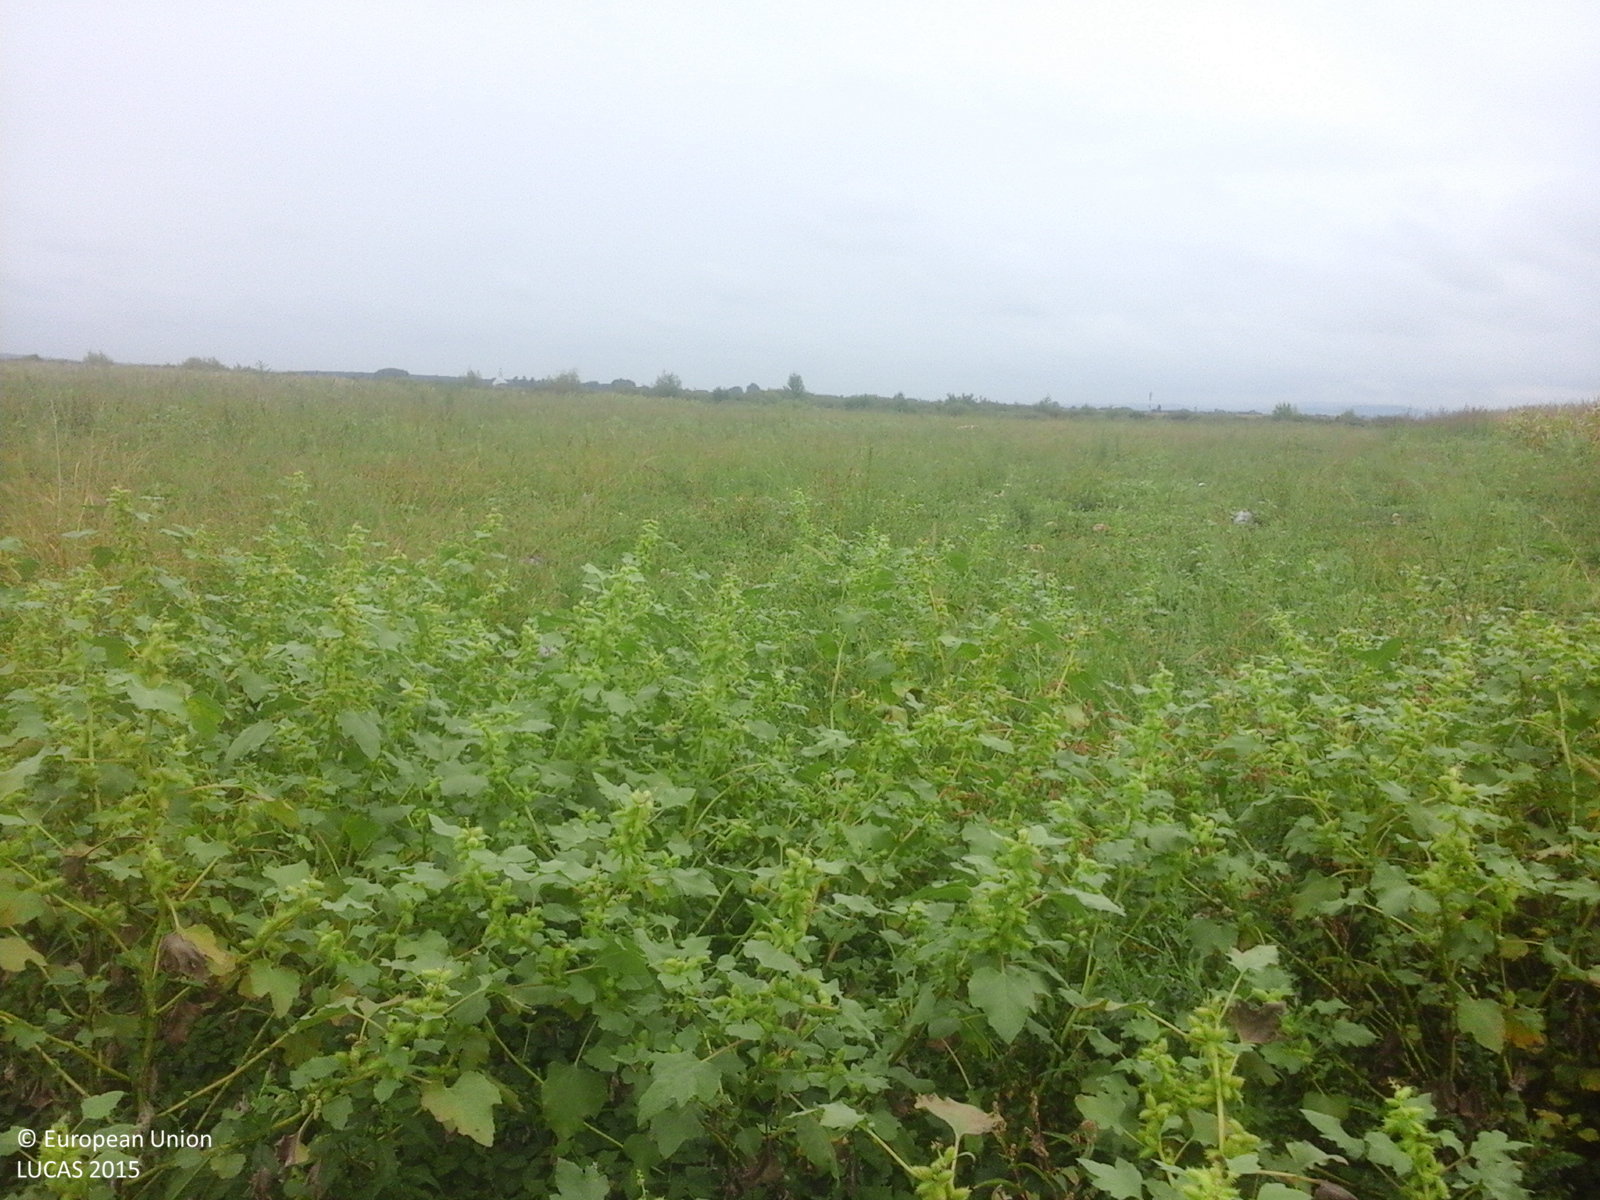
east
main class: Cropland
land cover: Maize
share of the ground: > 75 %
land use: Agriculture (excluding fallow land and kitchen gardens)
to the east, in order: Maize; Shrubland with sparse tree cover; Ditches and canals; Shrubland with sparse tree cover; Maize
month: September
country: RO
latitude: 47.2198
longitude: 21.9989
